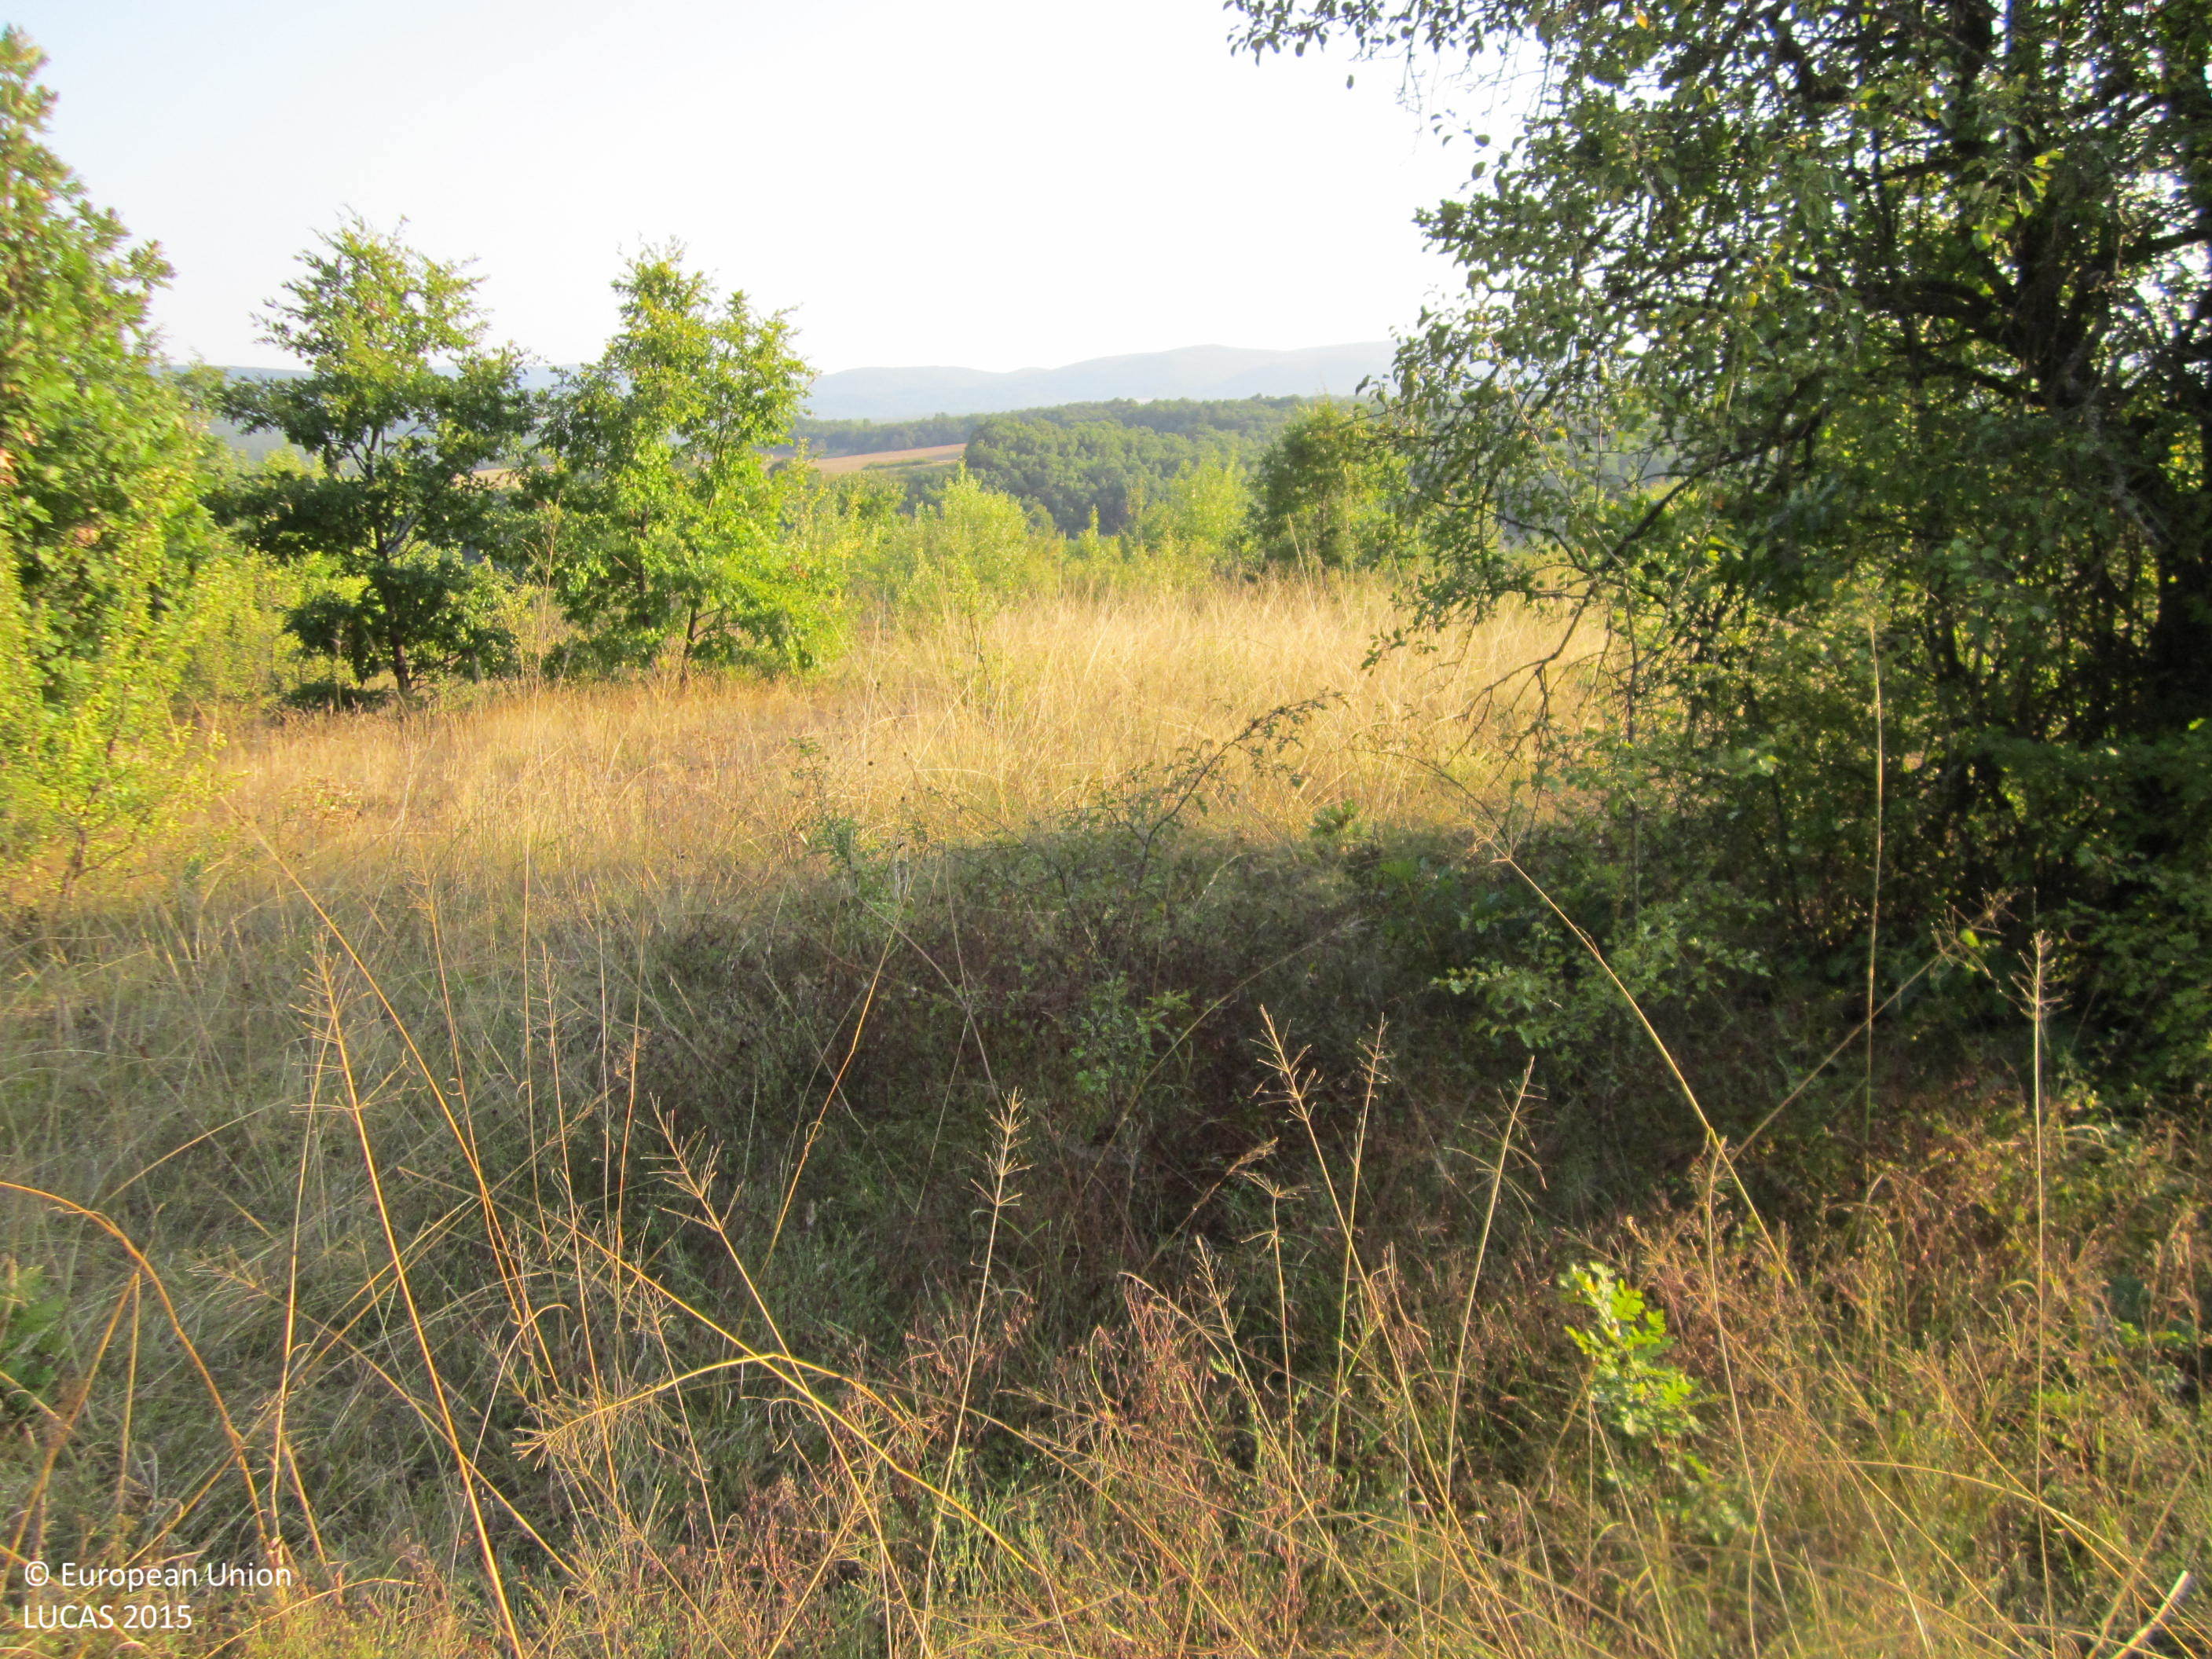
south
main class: Woodland
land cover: Broadleaved woodland
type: mesophytic deciduous forest
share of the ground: 25 - 50 %
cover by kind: herbaceous plants 60 %, broadleaved forest trees 35 %, shrubs 5 %
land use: Semi-natural and natural areas not in use
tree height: > 5 m
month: September
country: BG
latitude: 42.8392
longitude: 27.1312
